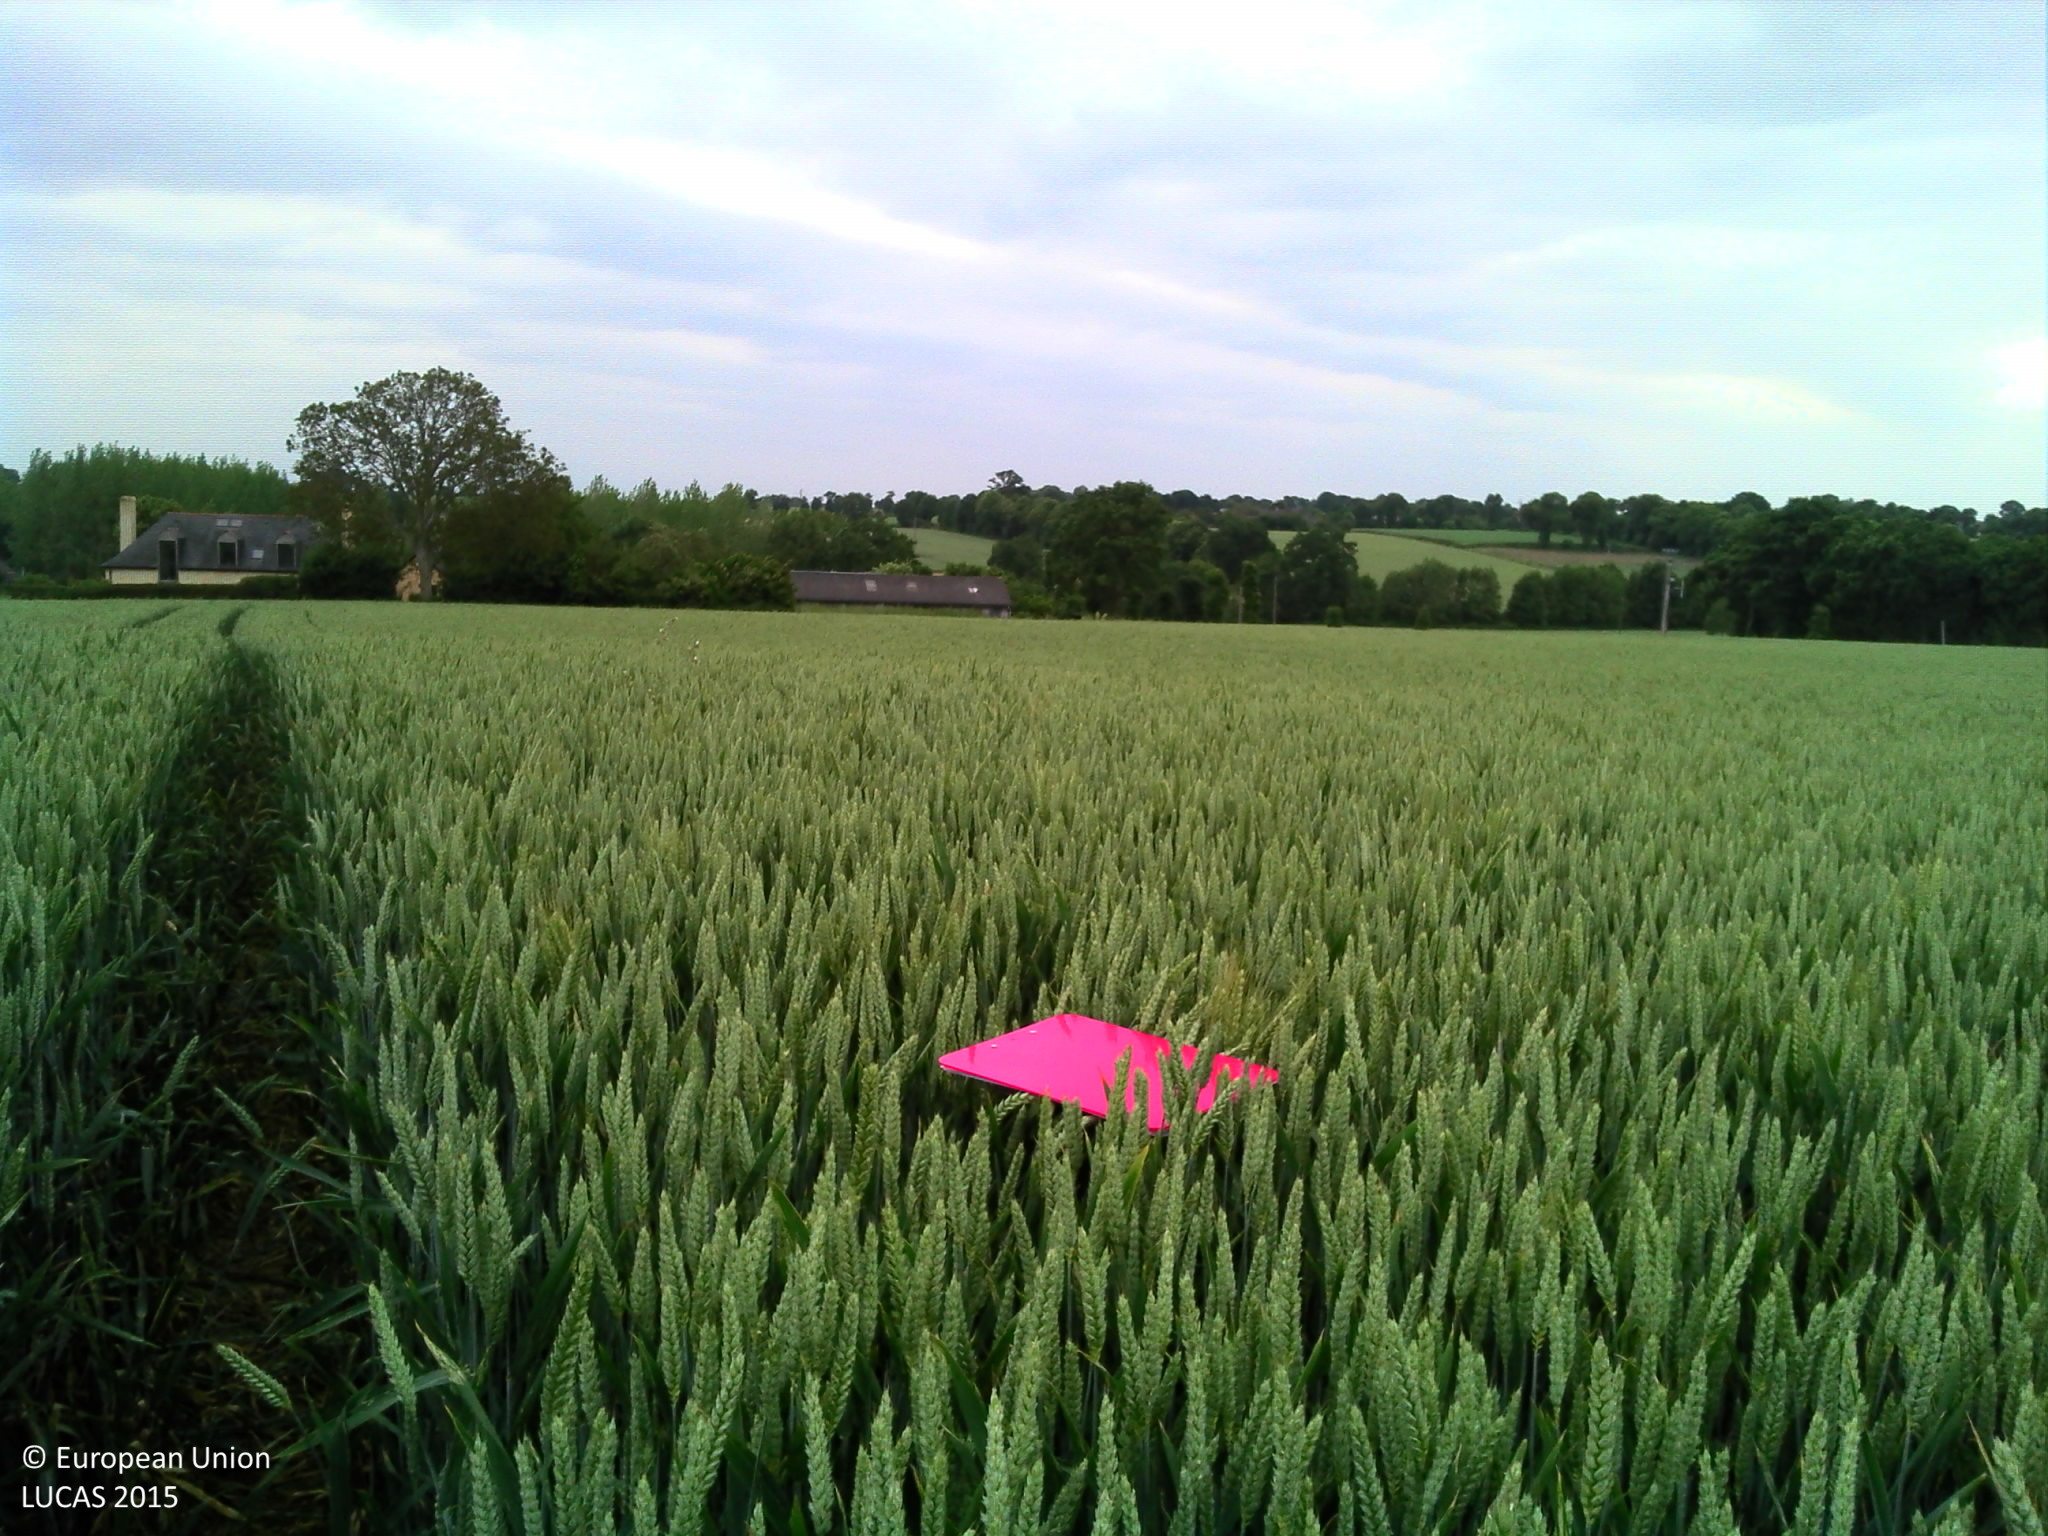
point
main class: Cropland
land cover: Common wheat
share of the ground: > 75 %
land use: Agriculture (excluding fallow land and kitchen gardens)
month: June
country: FR
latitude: 48.2023
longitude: -1.6599
